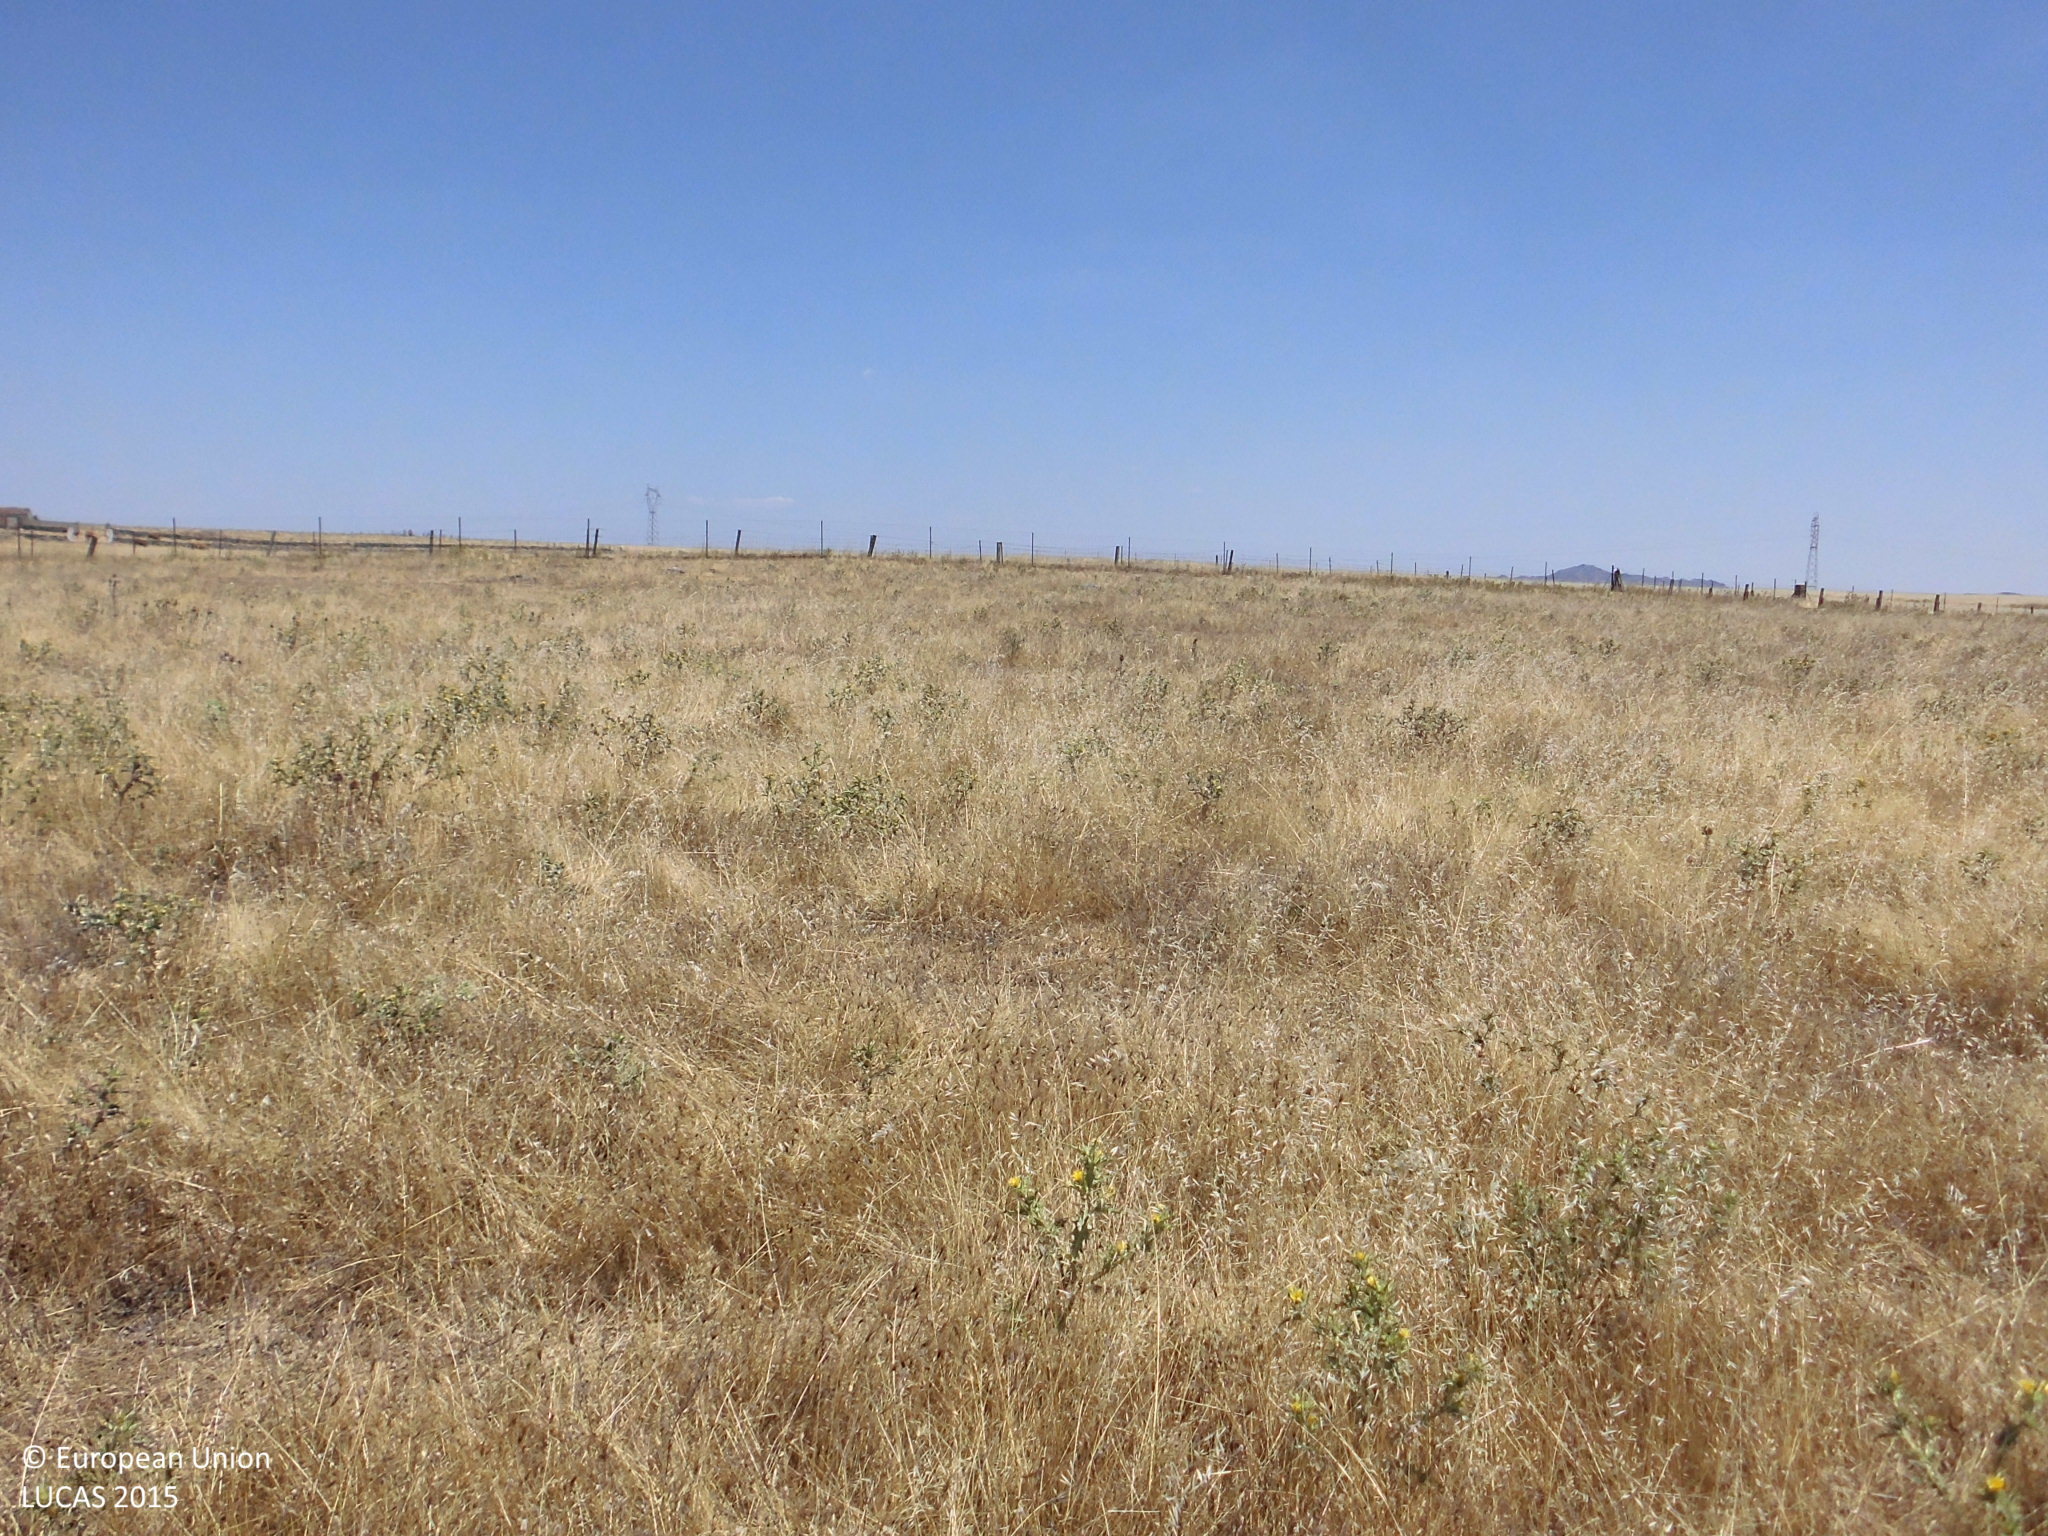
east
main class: Grassland
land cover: Grassland without tree/shrub cover
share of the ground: > 75 %
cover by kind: herbaceous plants 100 %
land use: Agriculture (excluding fallow land and kitchen gardens)
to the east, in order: Grassland without tree/shrub cover; Fences; Grassland without tree/shrub cover; Fences; Grassland without tree/shrub cover
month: June
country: ES
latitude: 39.3725
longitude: -5.9727
